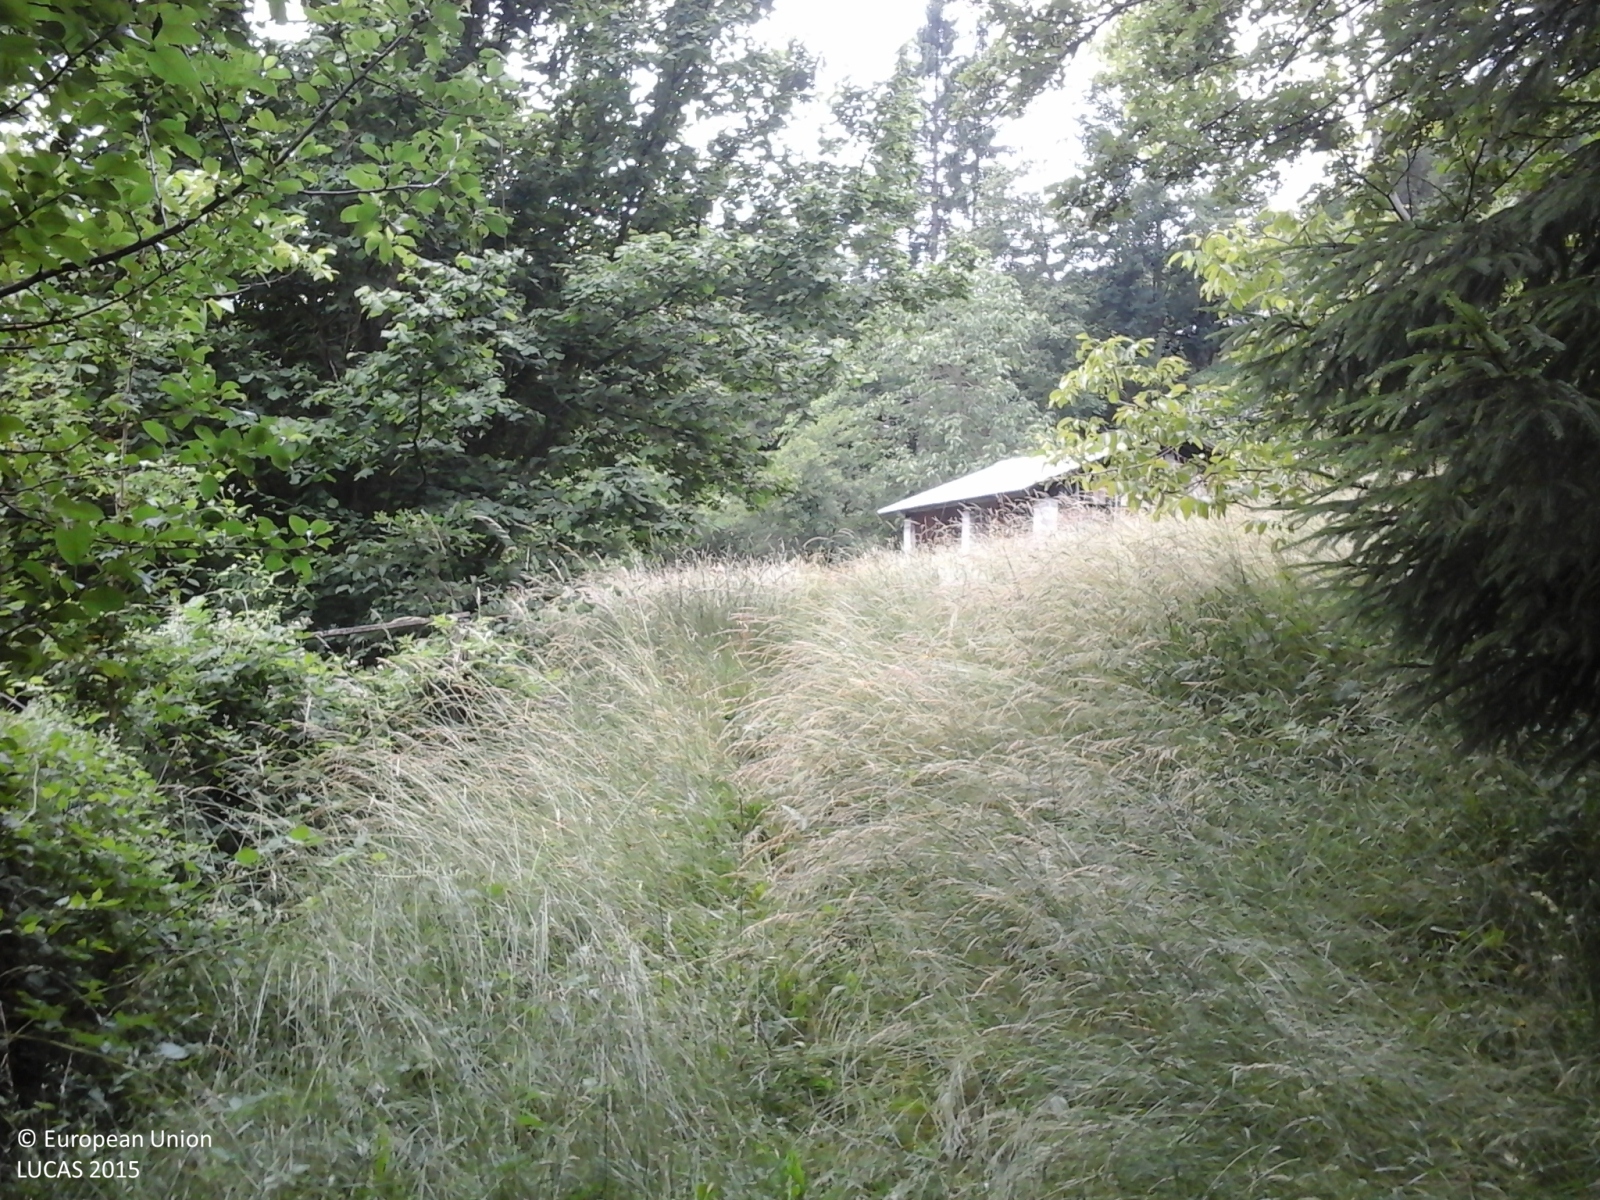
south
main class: Woodland
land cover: Broadleaved woodland
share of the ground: > 75 %
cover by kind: broadleaved forest trees 80 %, coniferous forest trees 20 %
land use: Forestry
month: June
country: IT
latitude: 44.5662
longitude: 9.6105
